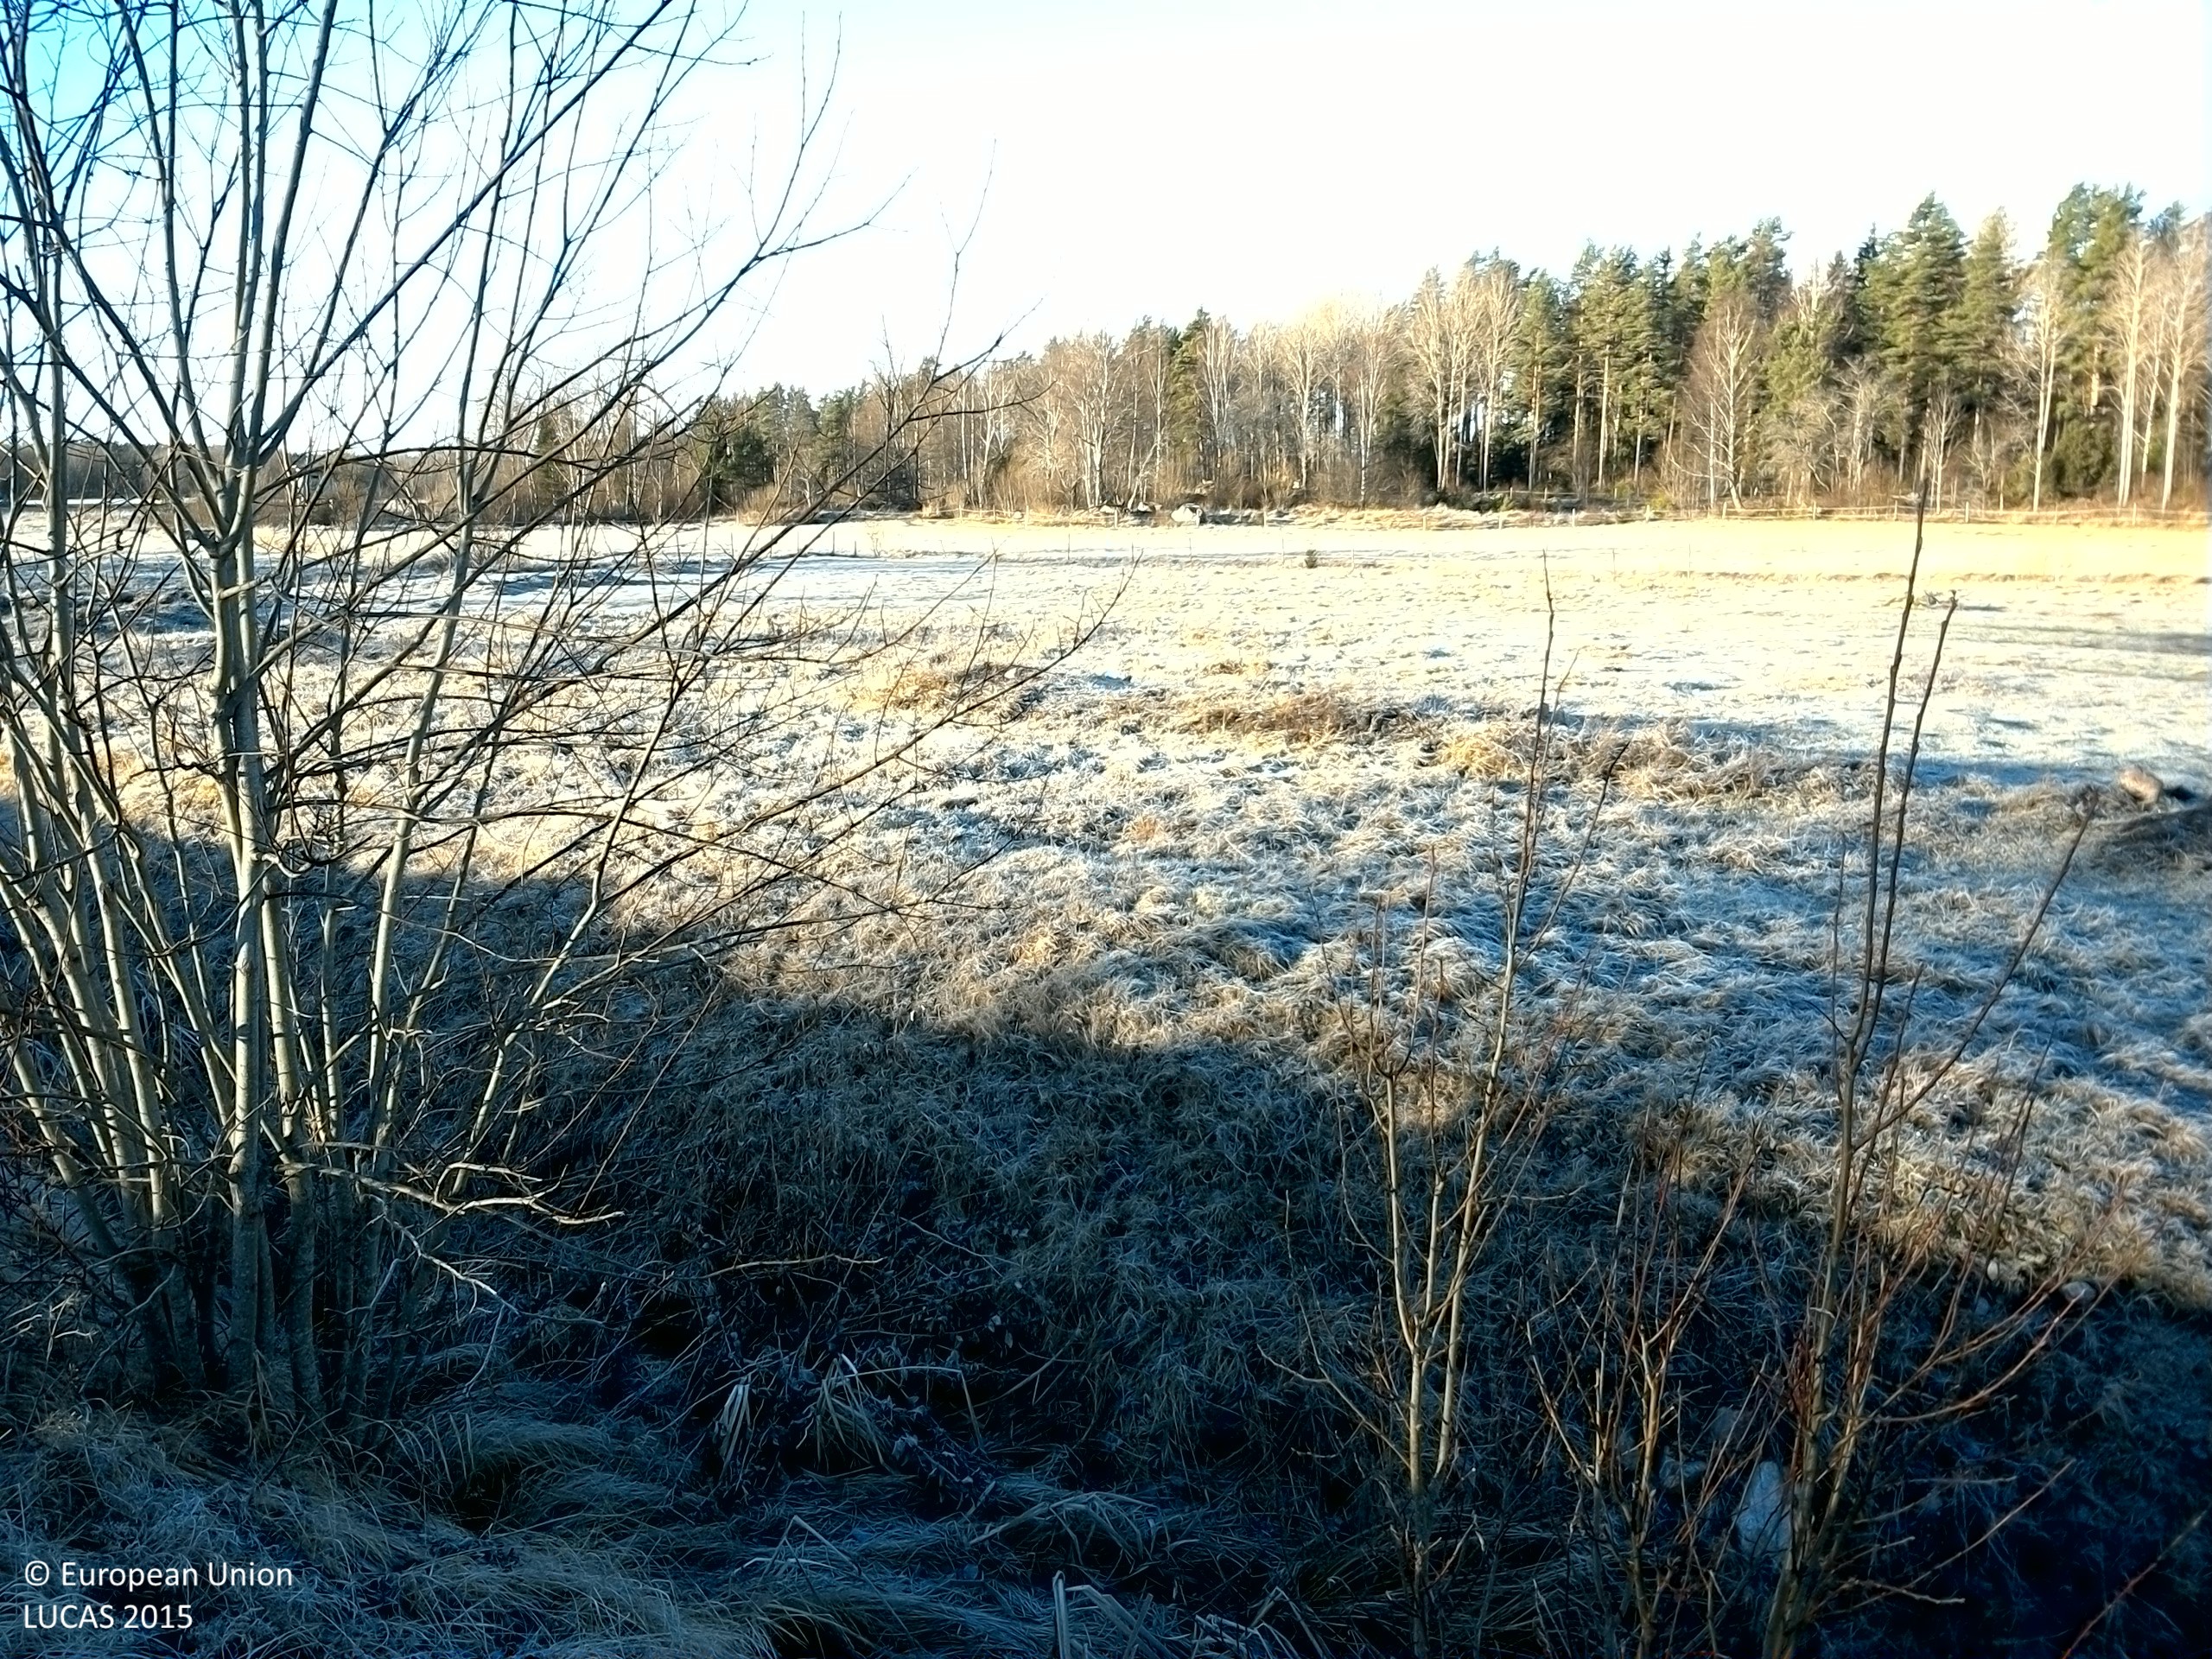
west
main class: Grassland
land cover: Grassland with sparse tree/shrub cover
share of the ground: > 75 %
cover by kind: herbaceous plants 95 %, broadleaved forest trees 5 %
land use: Fallow land
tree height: < 5 m
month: December
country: SE
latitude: 59.3517
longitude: 16.3417
